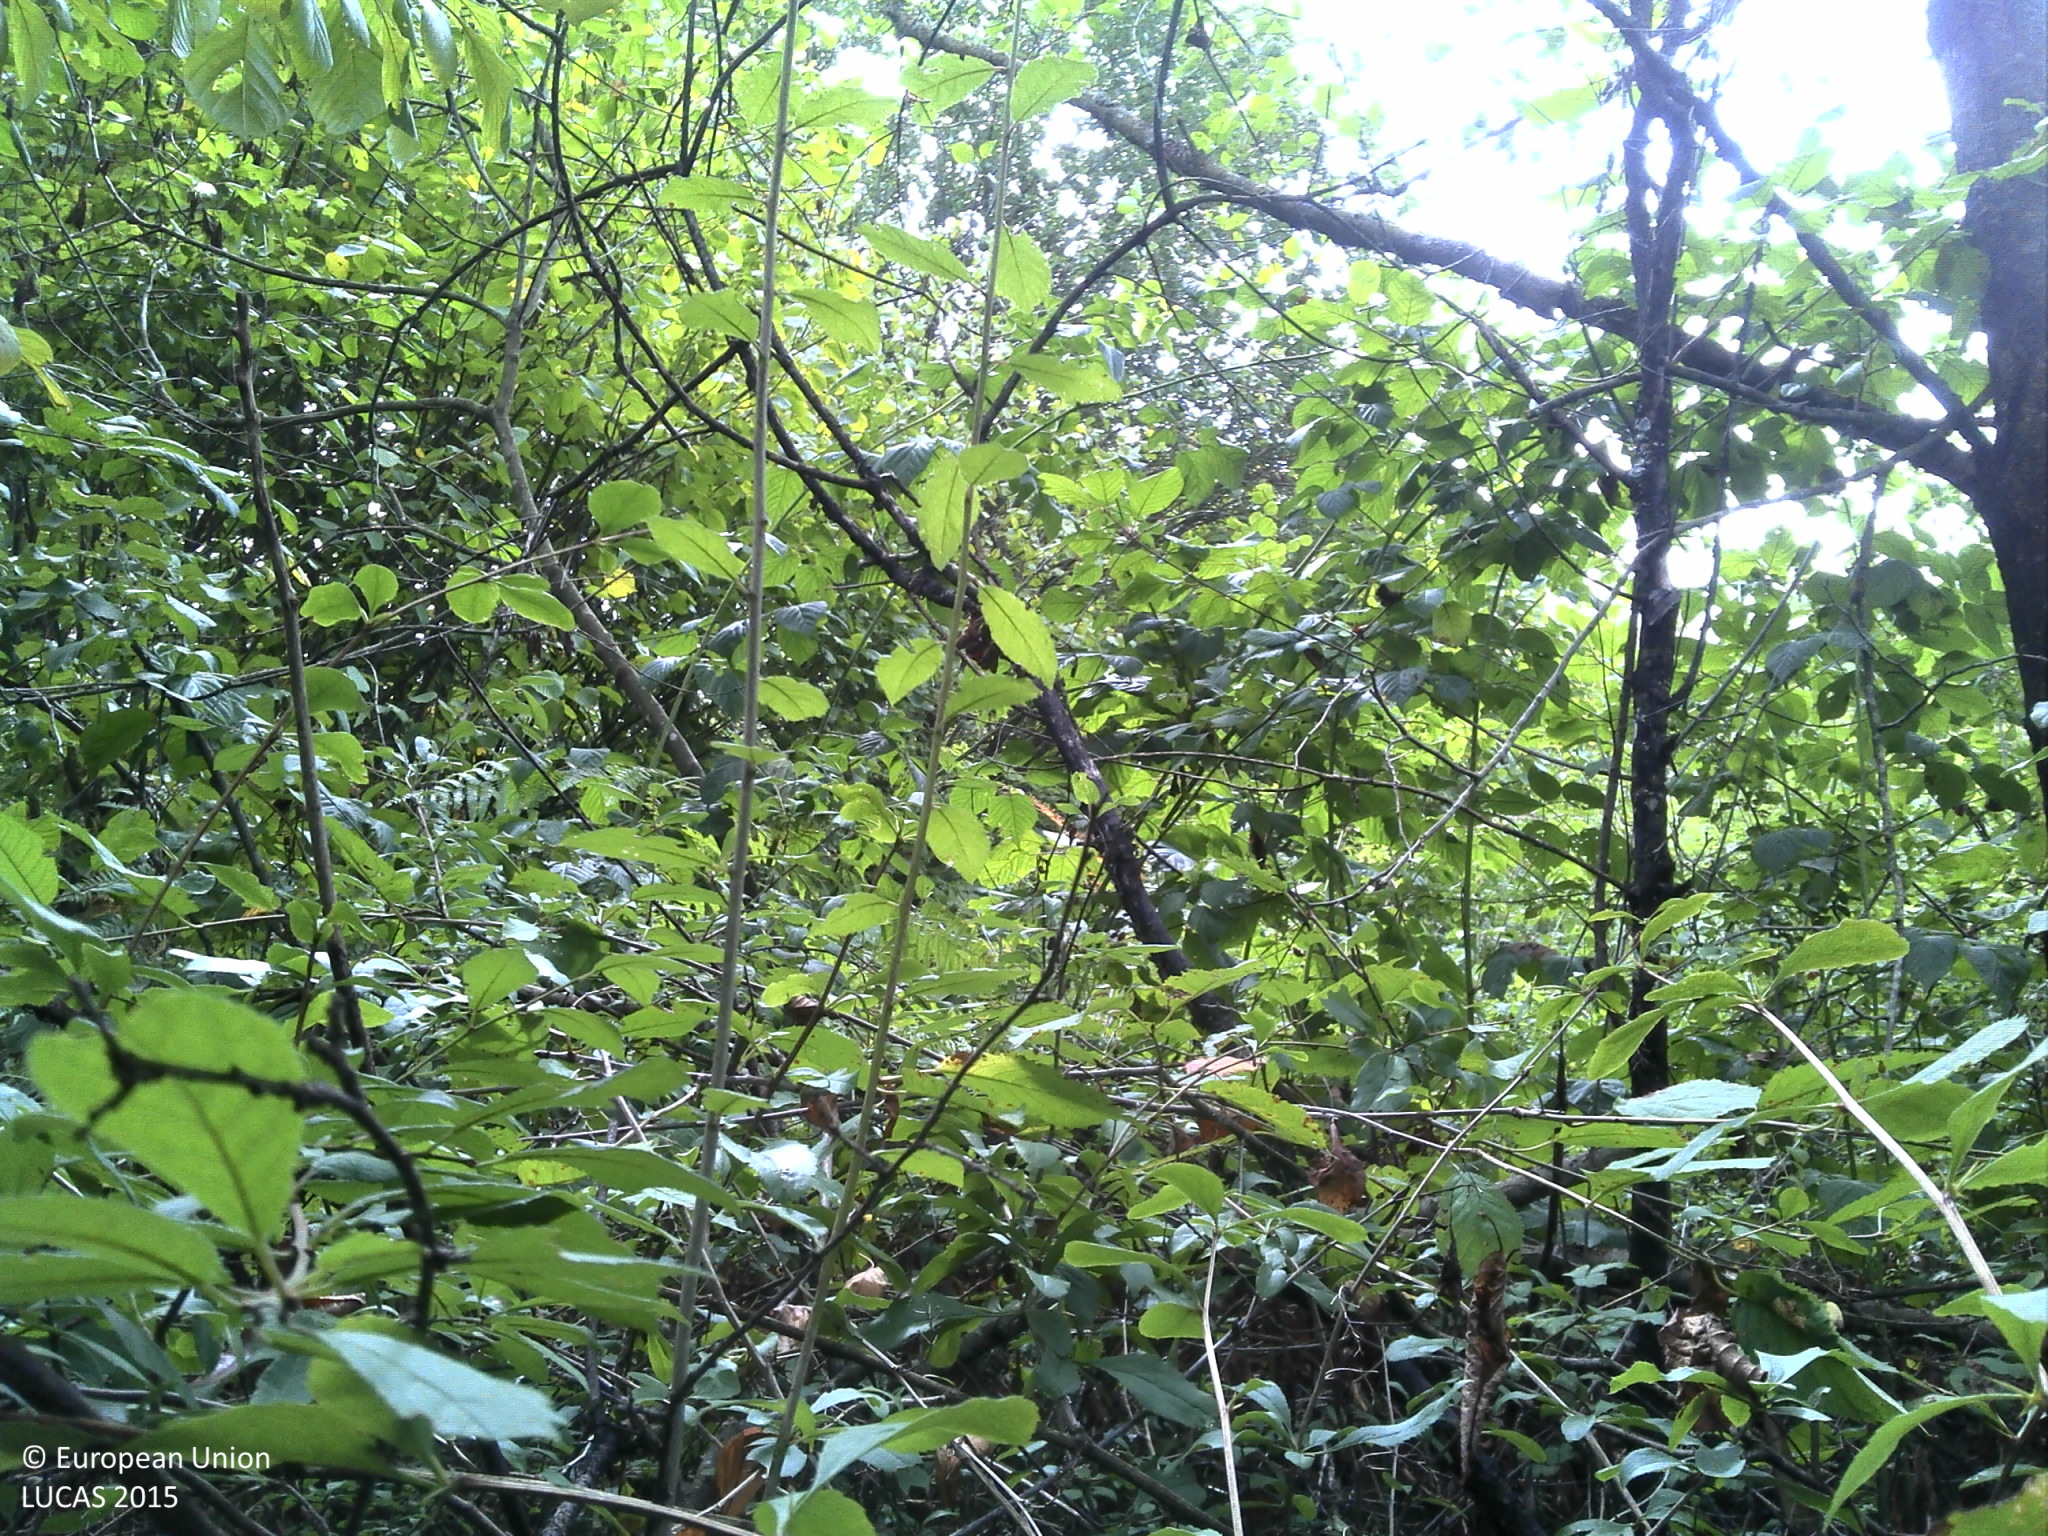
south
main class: Woodland
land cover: Broadleaved woodland
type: beech forest
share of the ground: > 75 %
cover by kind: broadleaved forest trees 100 %
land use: Forestry
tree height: > 5 m
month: August
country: HR
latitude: 45.3863
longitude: 15.7053
